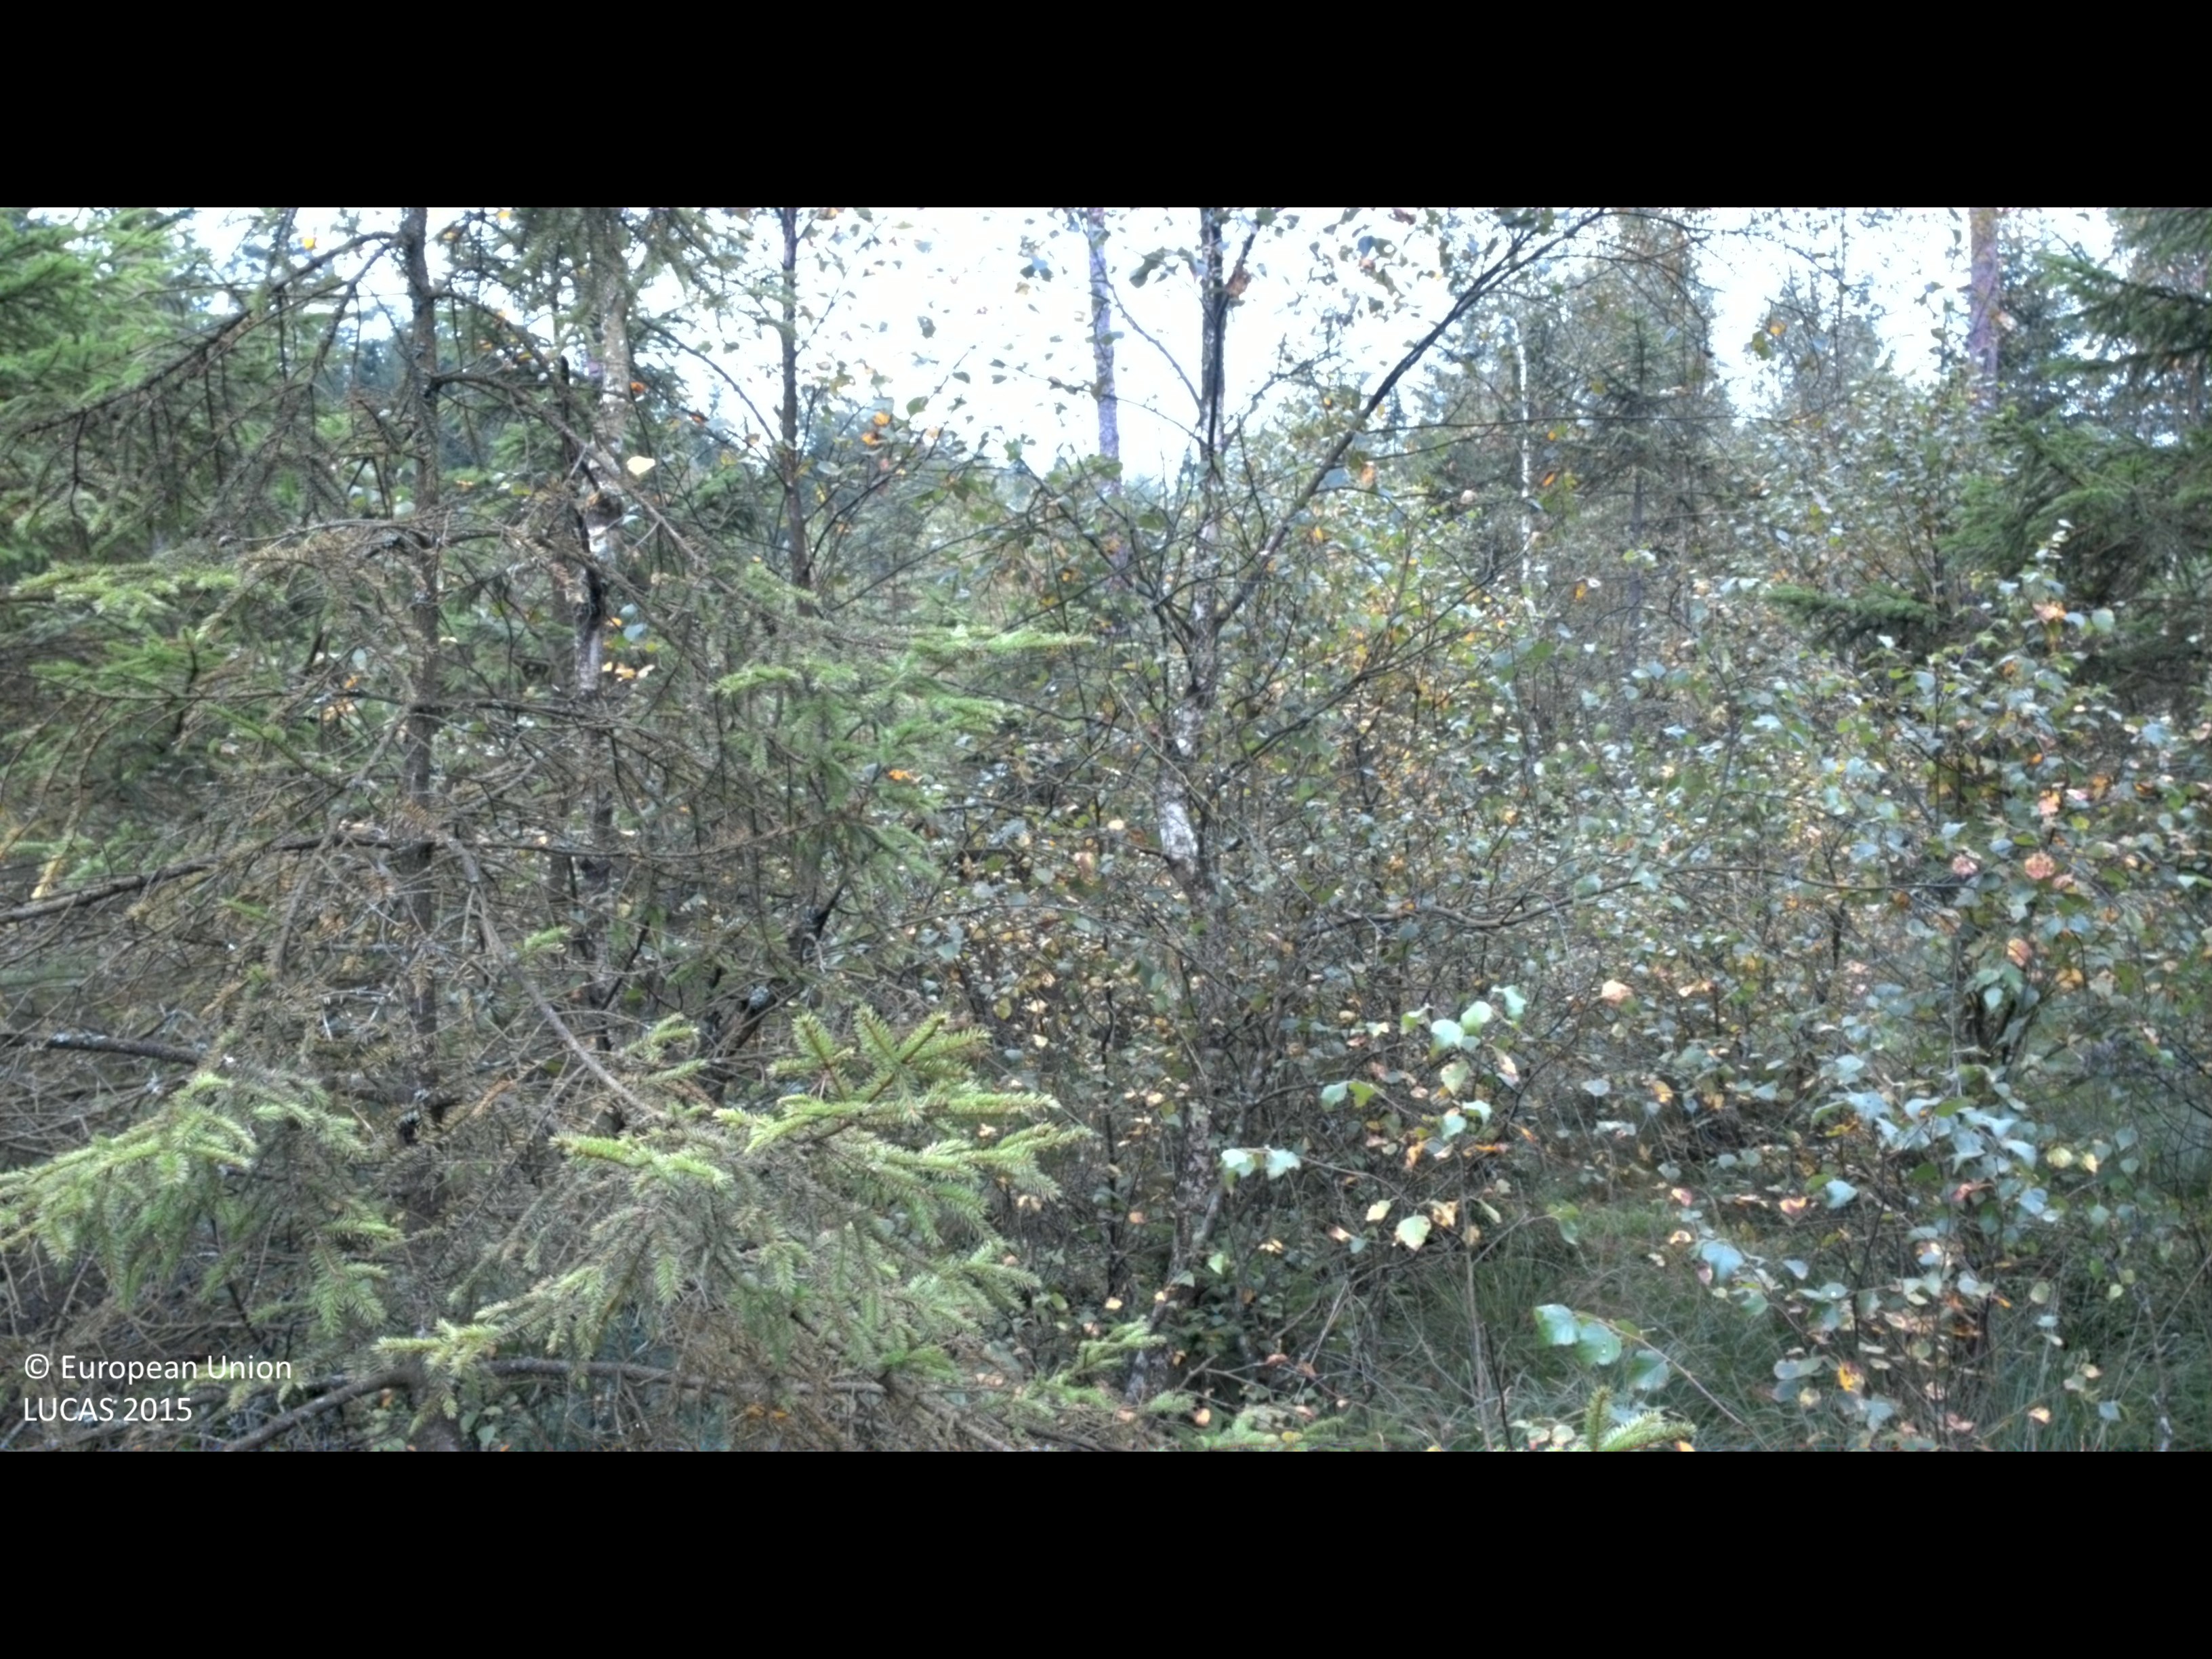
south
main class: Woodland
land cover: Spruce dominated mixed woodland
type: boreal forest
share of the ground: 50 - 75 %
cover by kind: coniferous forest trees 35 %, broadleaved forest trees 35 %, shrubs 15 %, herbaceous plants 15 %
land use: Forestry
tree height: < 5 m
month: September
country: SE
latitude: 56.8229
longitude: 12.7986
